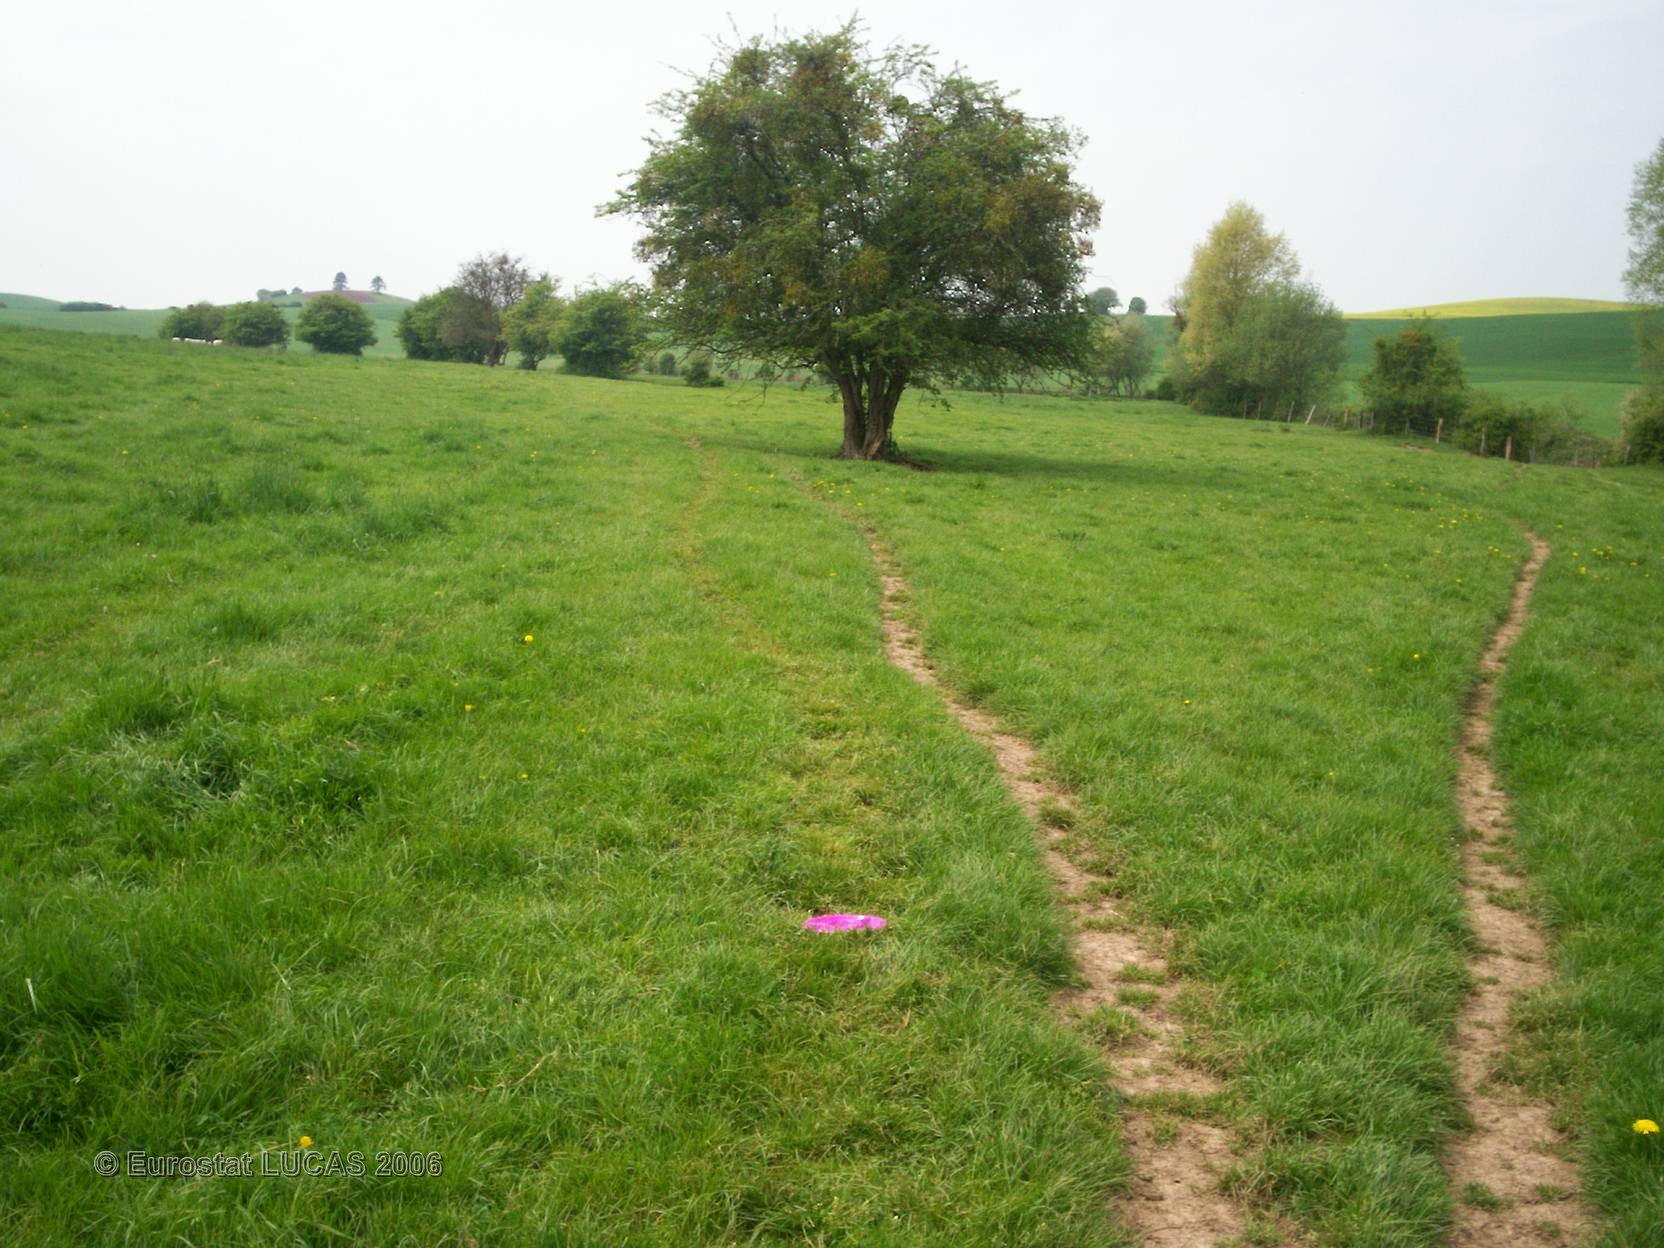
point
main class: Grassland
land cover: Grassland with sparse tree/shrub cover
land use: Agriculture (excluding fallow land and kitchen gardens)
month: May
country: FR
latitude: 48.8613
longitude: 6.7971
